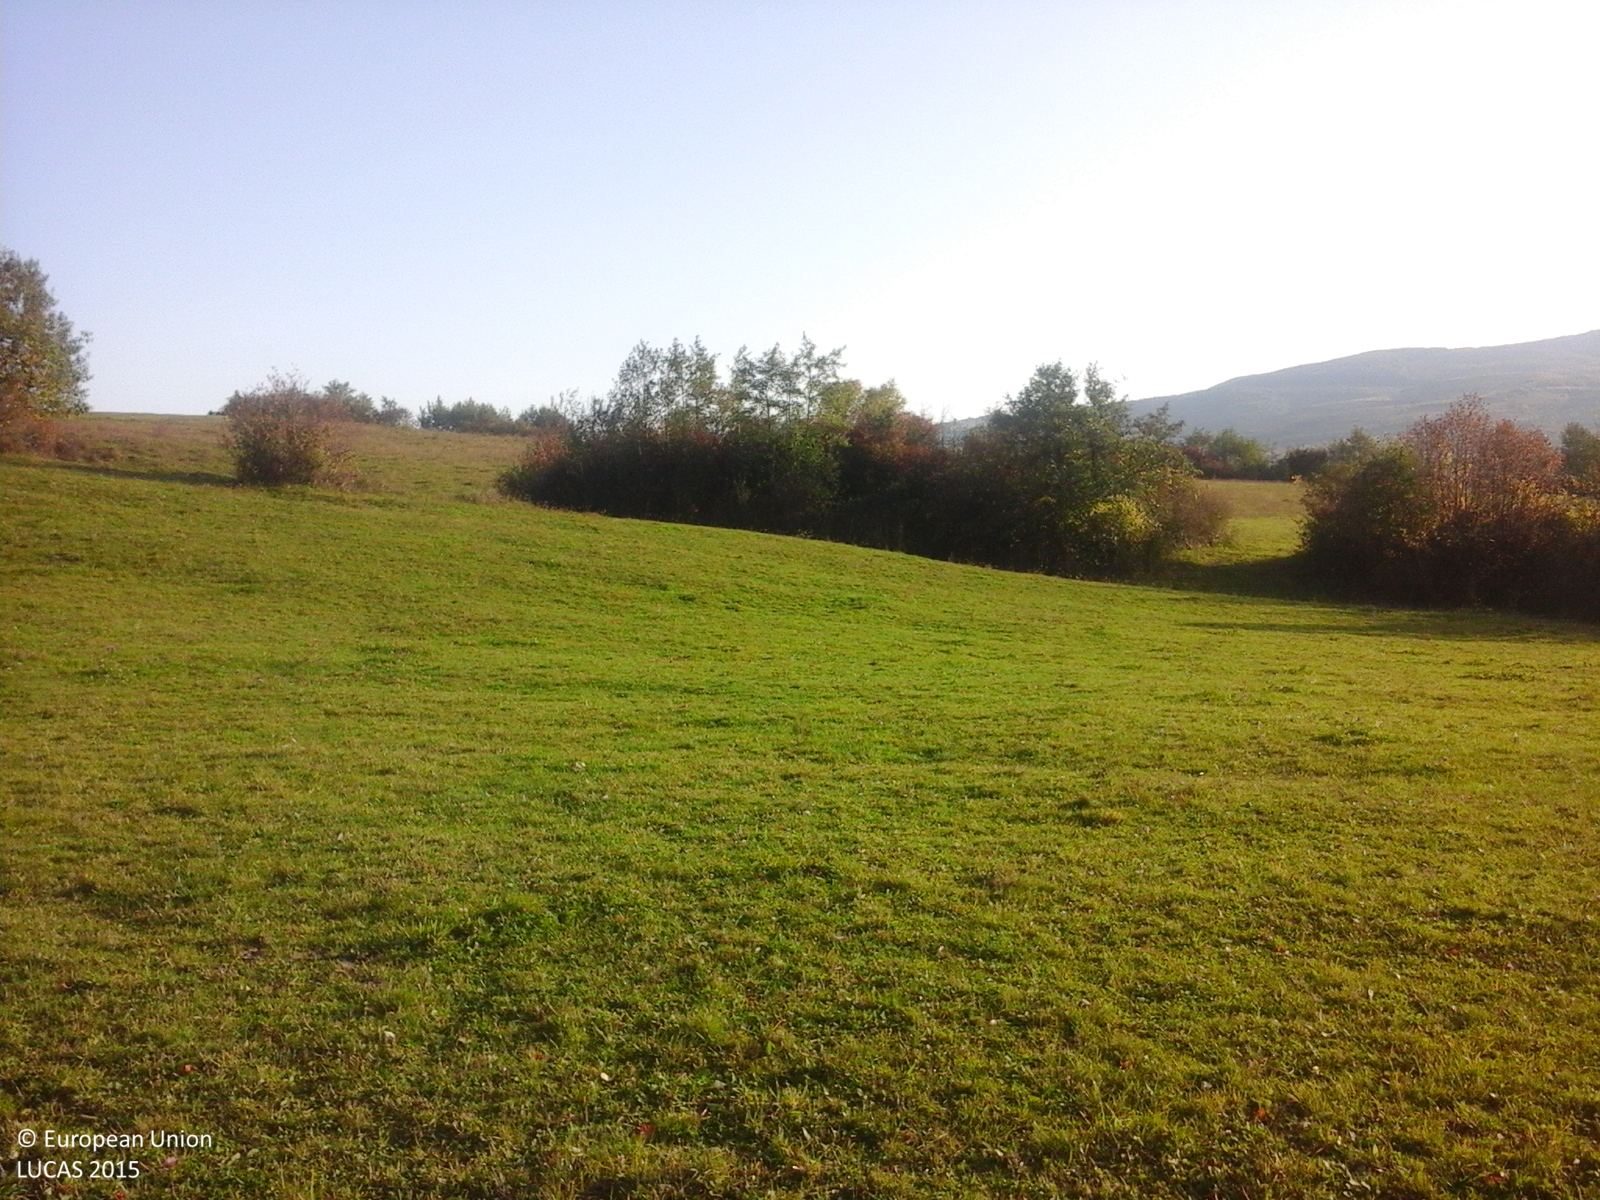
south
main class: Grassland
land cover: Grassland without tree/shrub cover
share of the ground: > 75 %
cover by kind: herbaceous plants 100 %
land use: Agriculture (excluding fallow land and kitchen gardens)
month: October
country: RO
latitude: 46.4878
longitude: 25.1738
